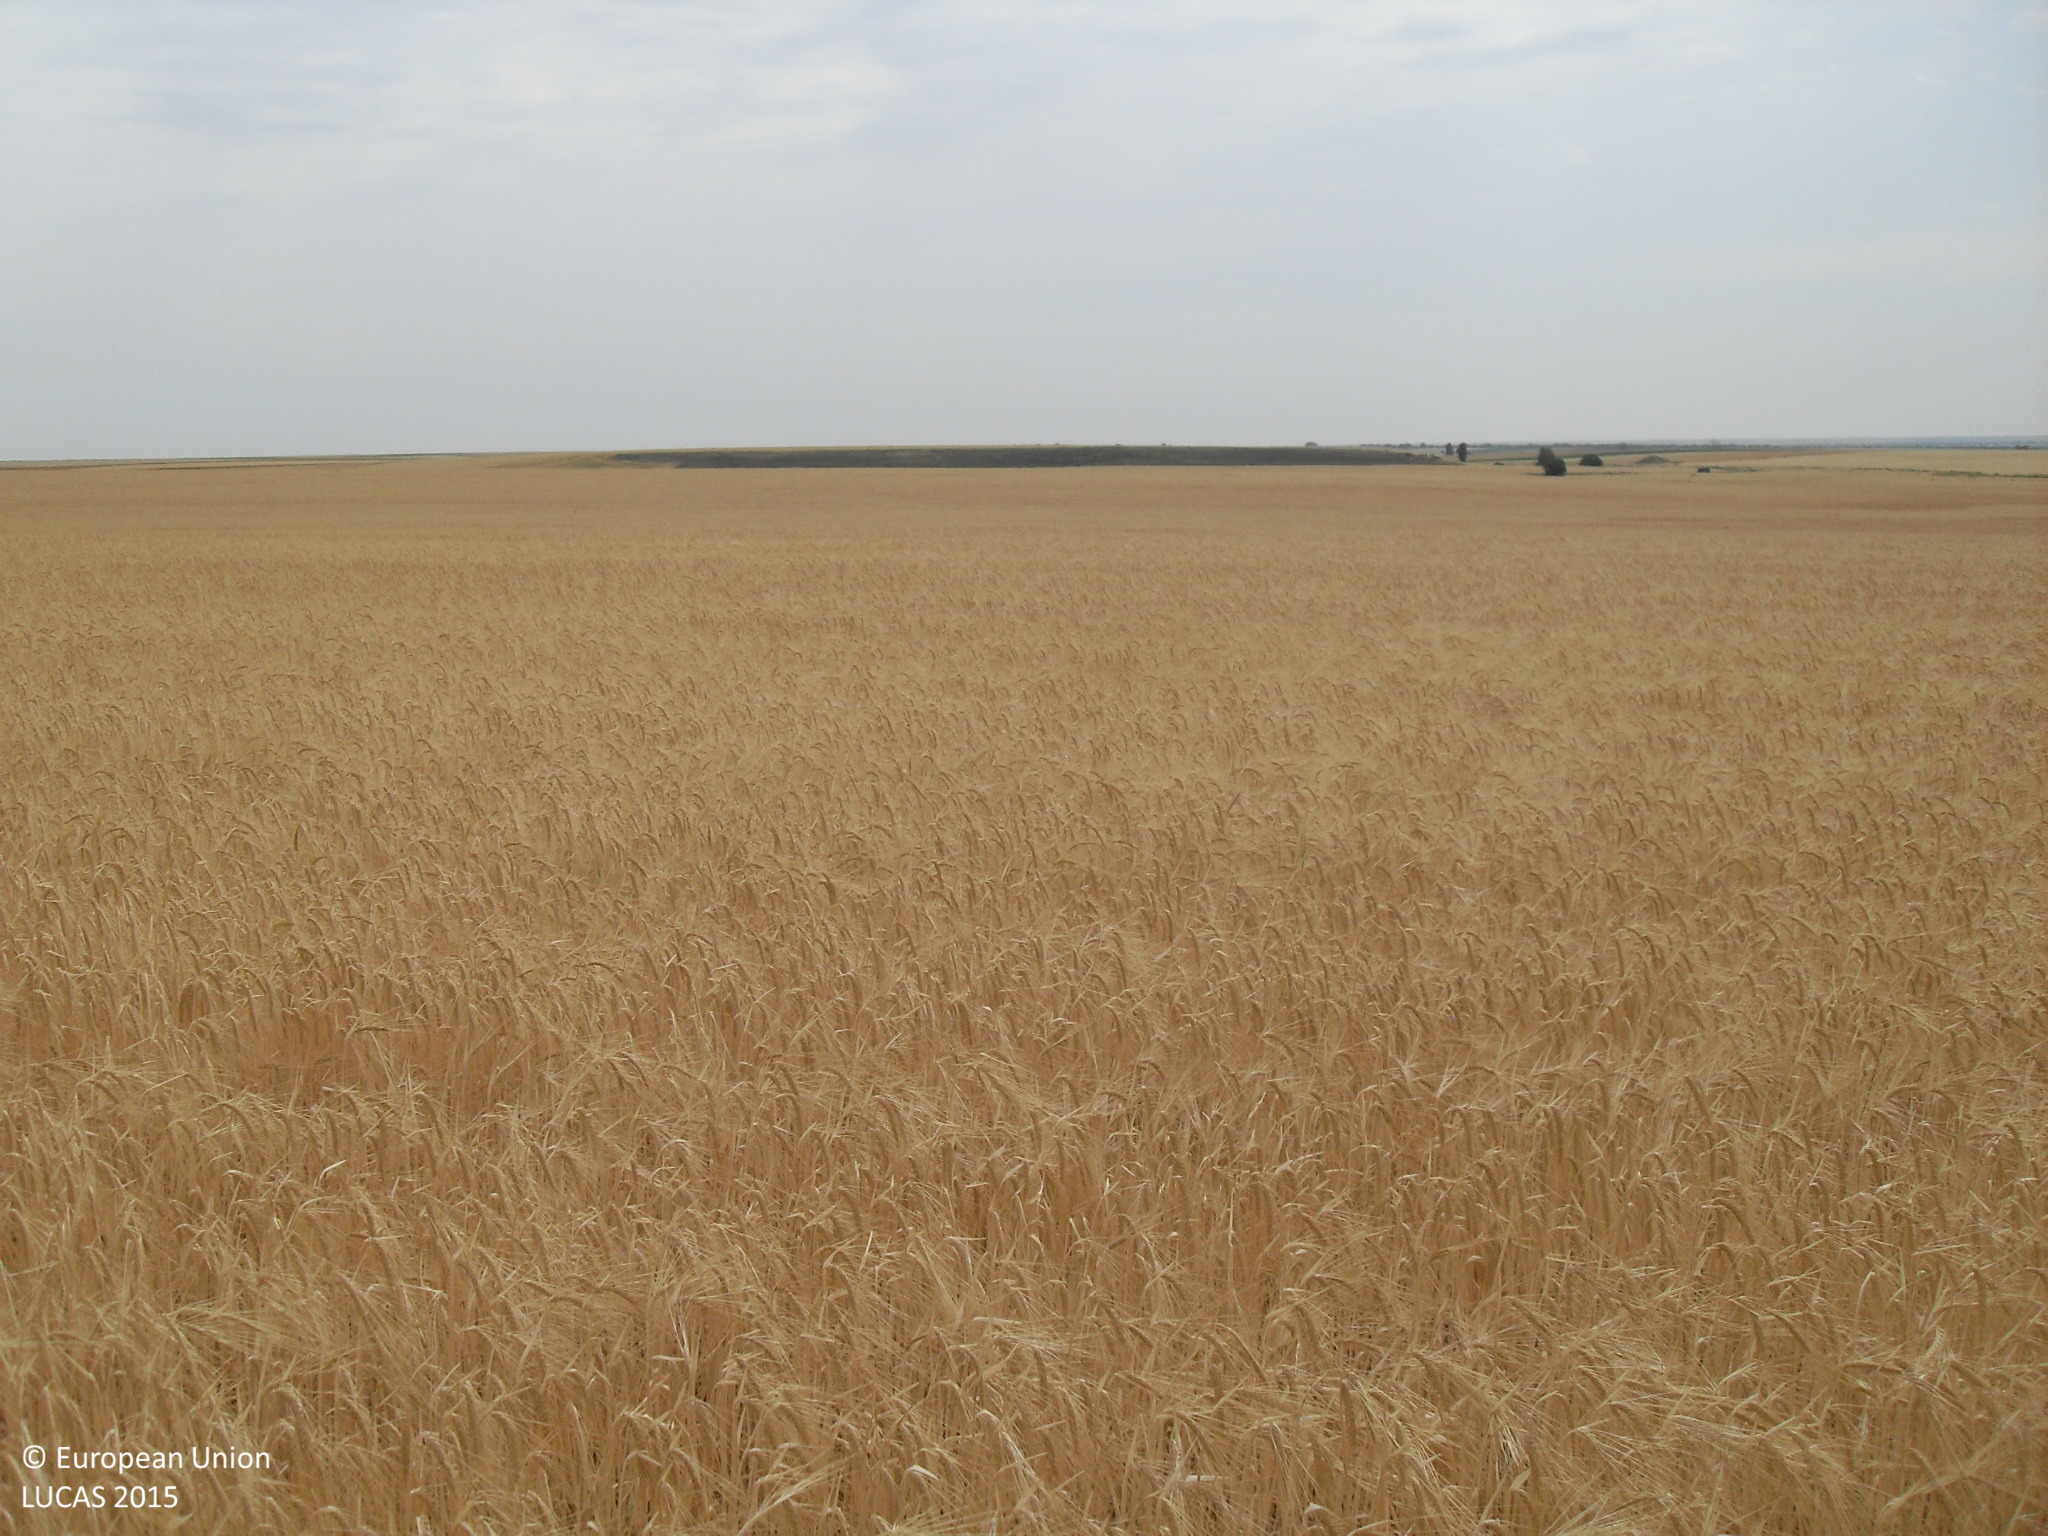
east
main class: Cropland
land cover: Barley
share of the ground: > 75 %
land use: Agriculture (excluding fallow land and kitchen gardens)
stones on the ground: < 10 %
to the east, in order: Barley
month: June
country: ES
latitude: 41.1329
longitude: -5.4302
